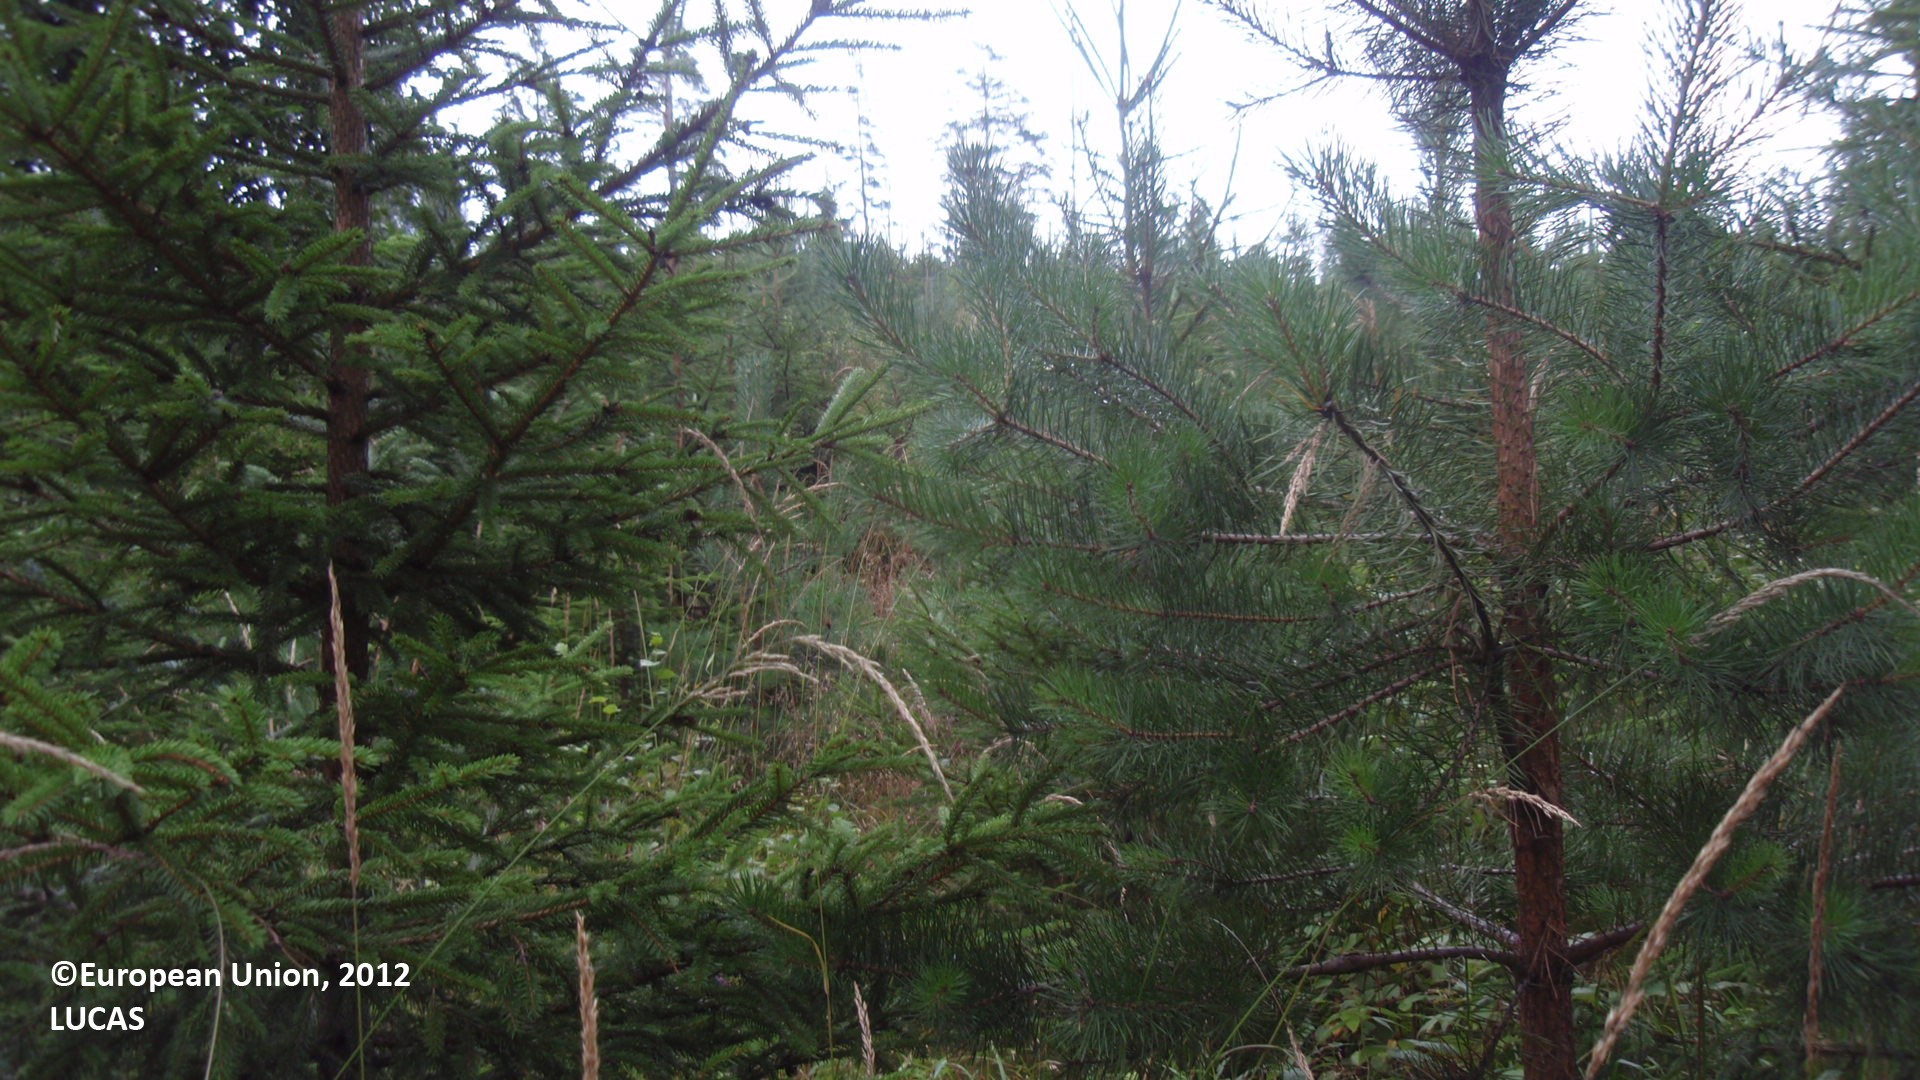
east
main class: Woodland
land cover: Spruce dominated mixed woodland
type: boreal forest
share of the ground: 25 - 50 %
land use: Forestry
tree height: < 5 m
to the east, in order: Spruce dominated mixed woodland; Grassland with sparse tree/shrub cover; Pine dominated coniferous woodland
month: August
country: FI
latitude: 60.9070
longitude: 27.4952
